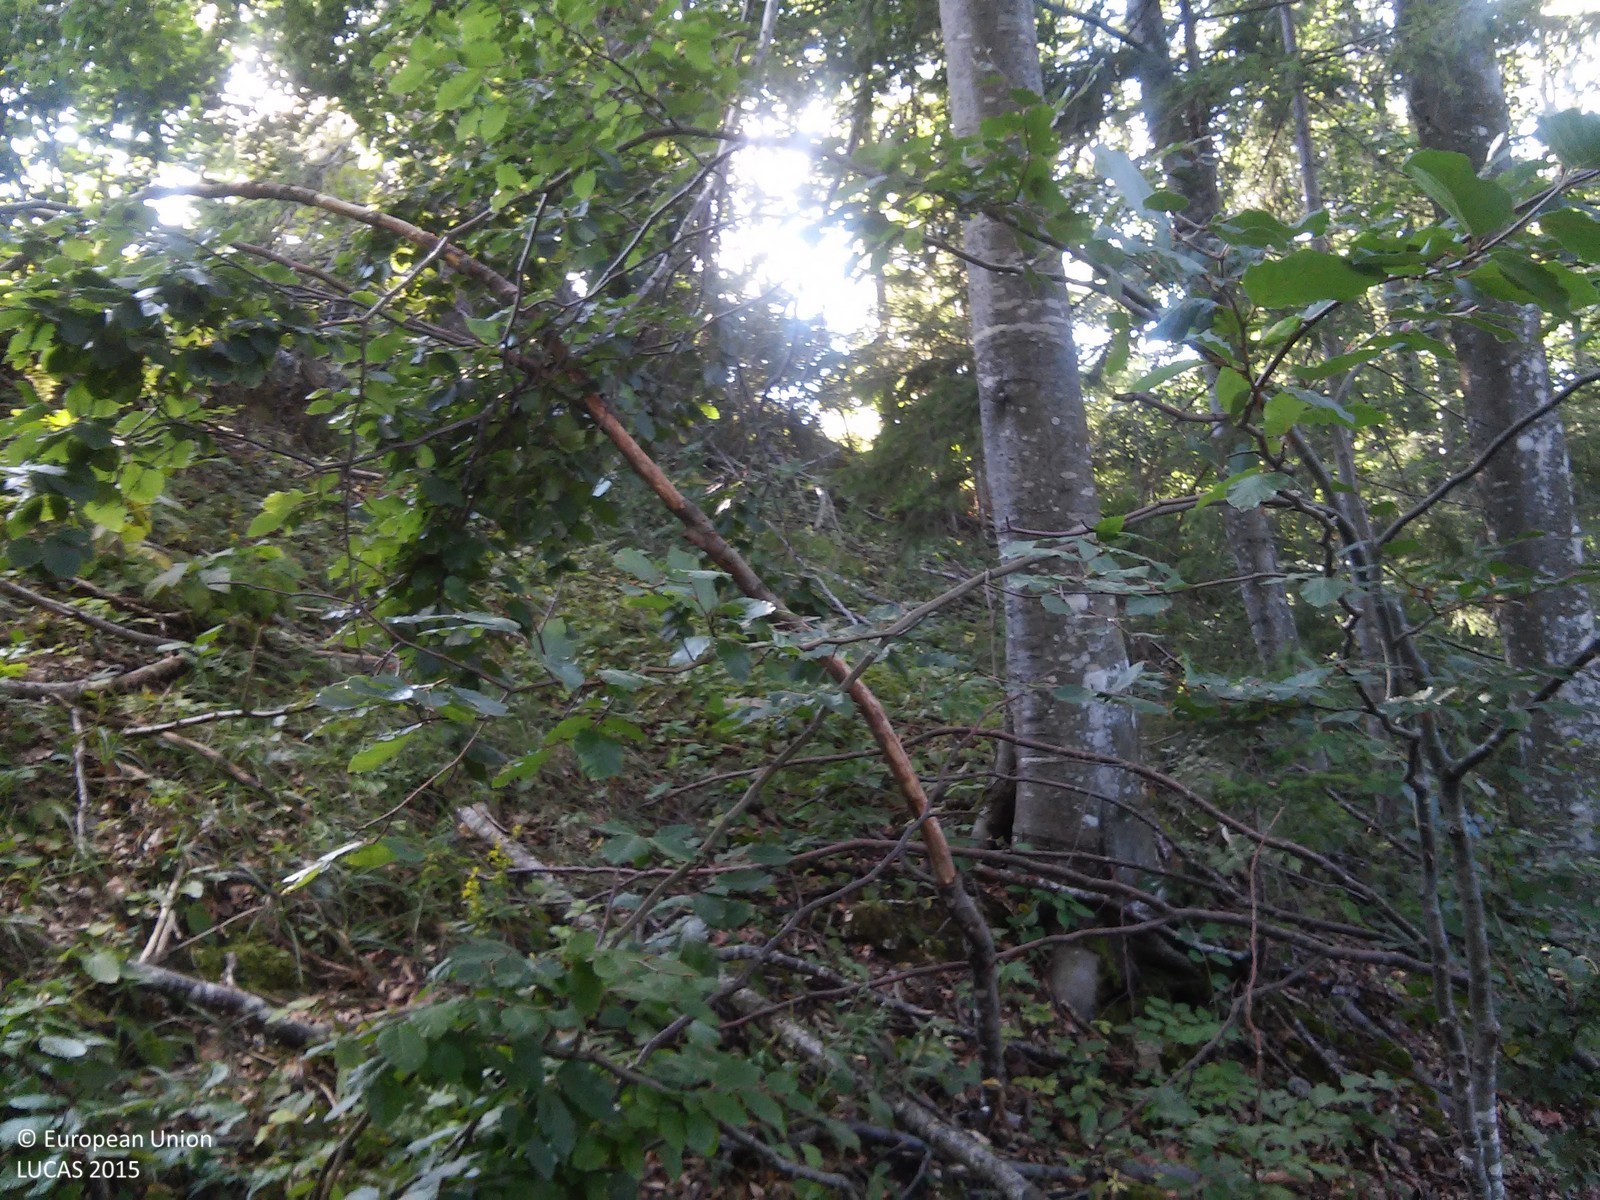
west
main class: Woodland
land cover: Other mixed woodland
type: mountainous beech forest
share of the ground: > 75 %
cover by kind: broadleaved forest trees 75 %, coniferous forest trees 25 %
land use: Forestry
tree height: > 5 m
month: September
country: HR
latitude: 45.6208
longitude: 14.5999
